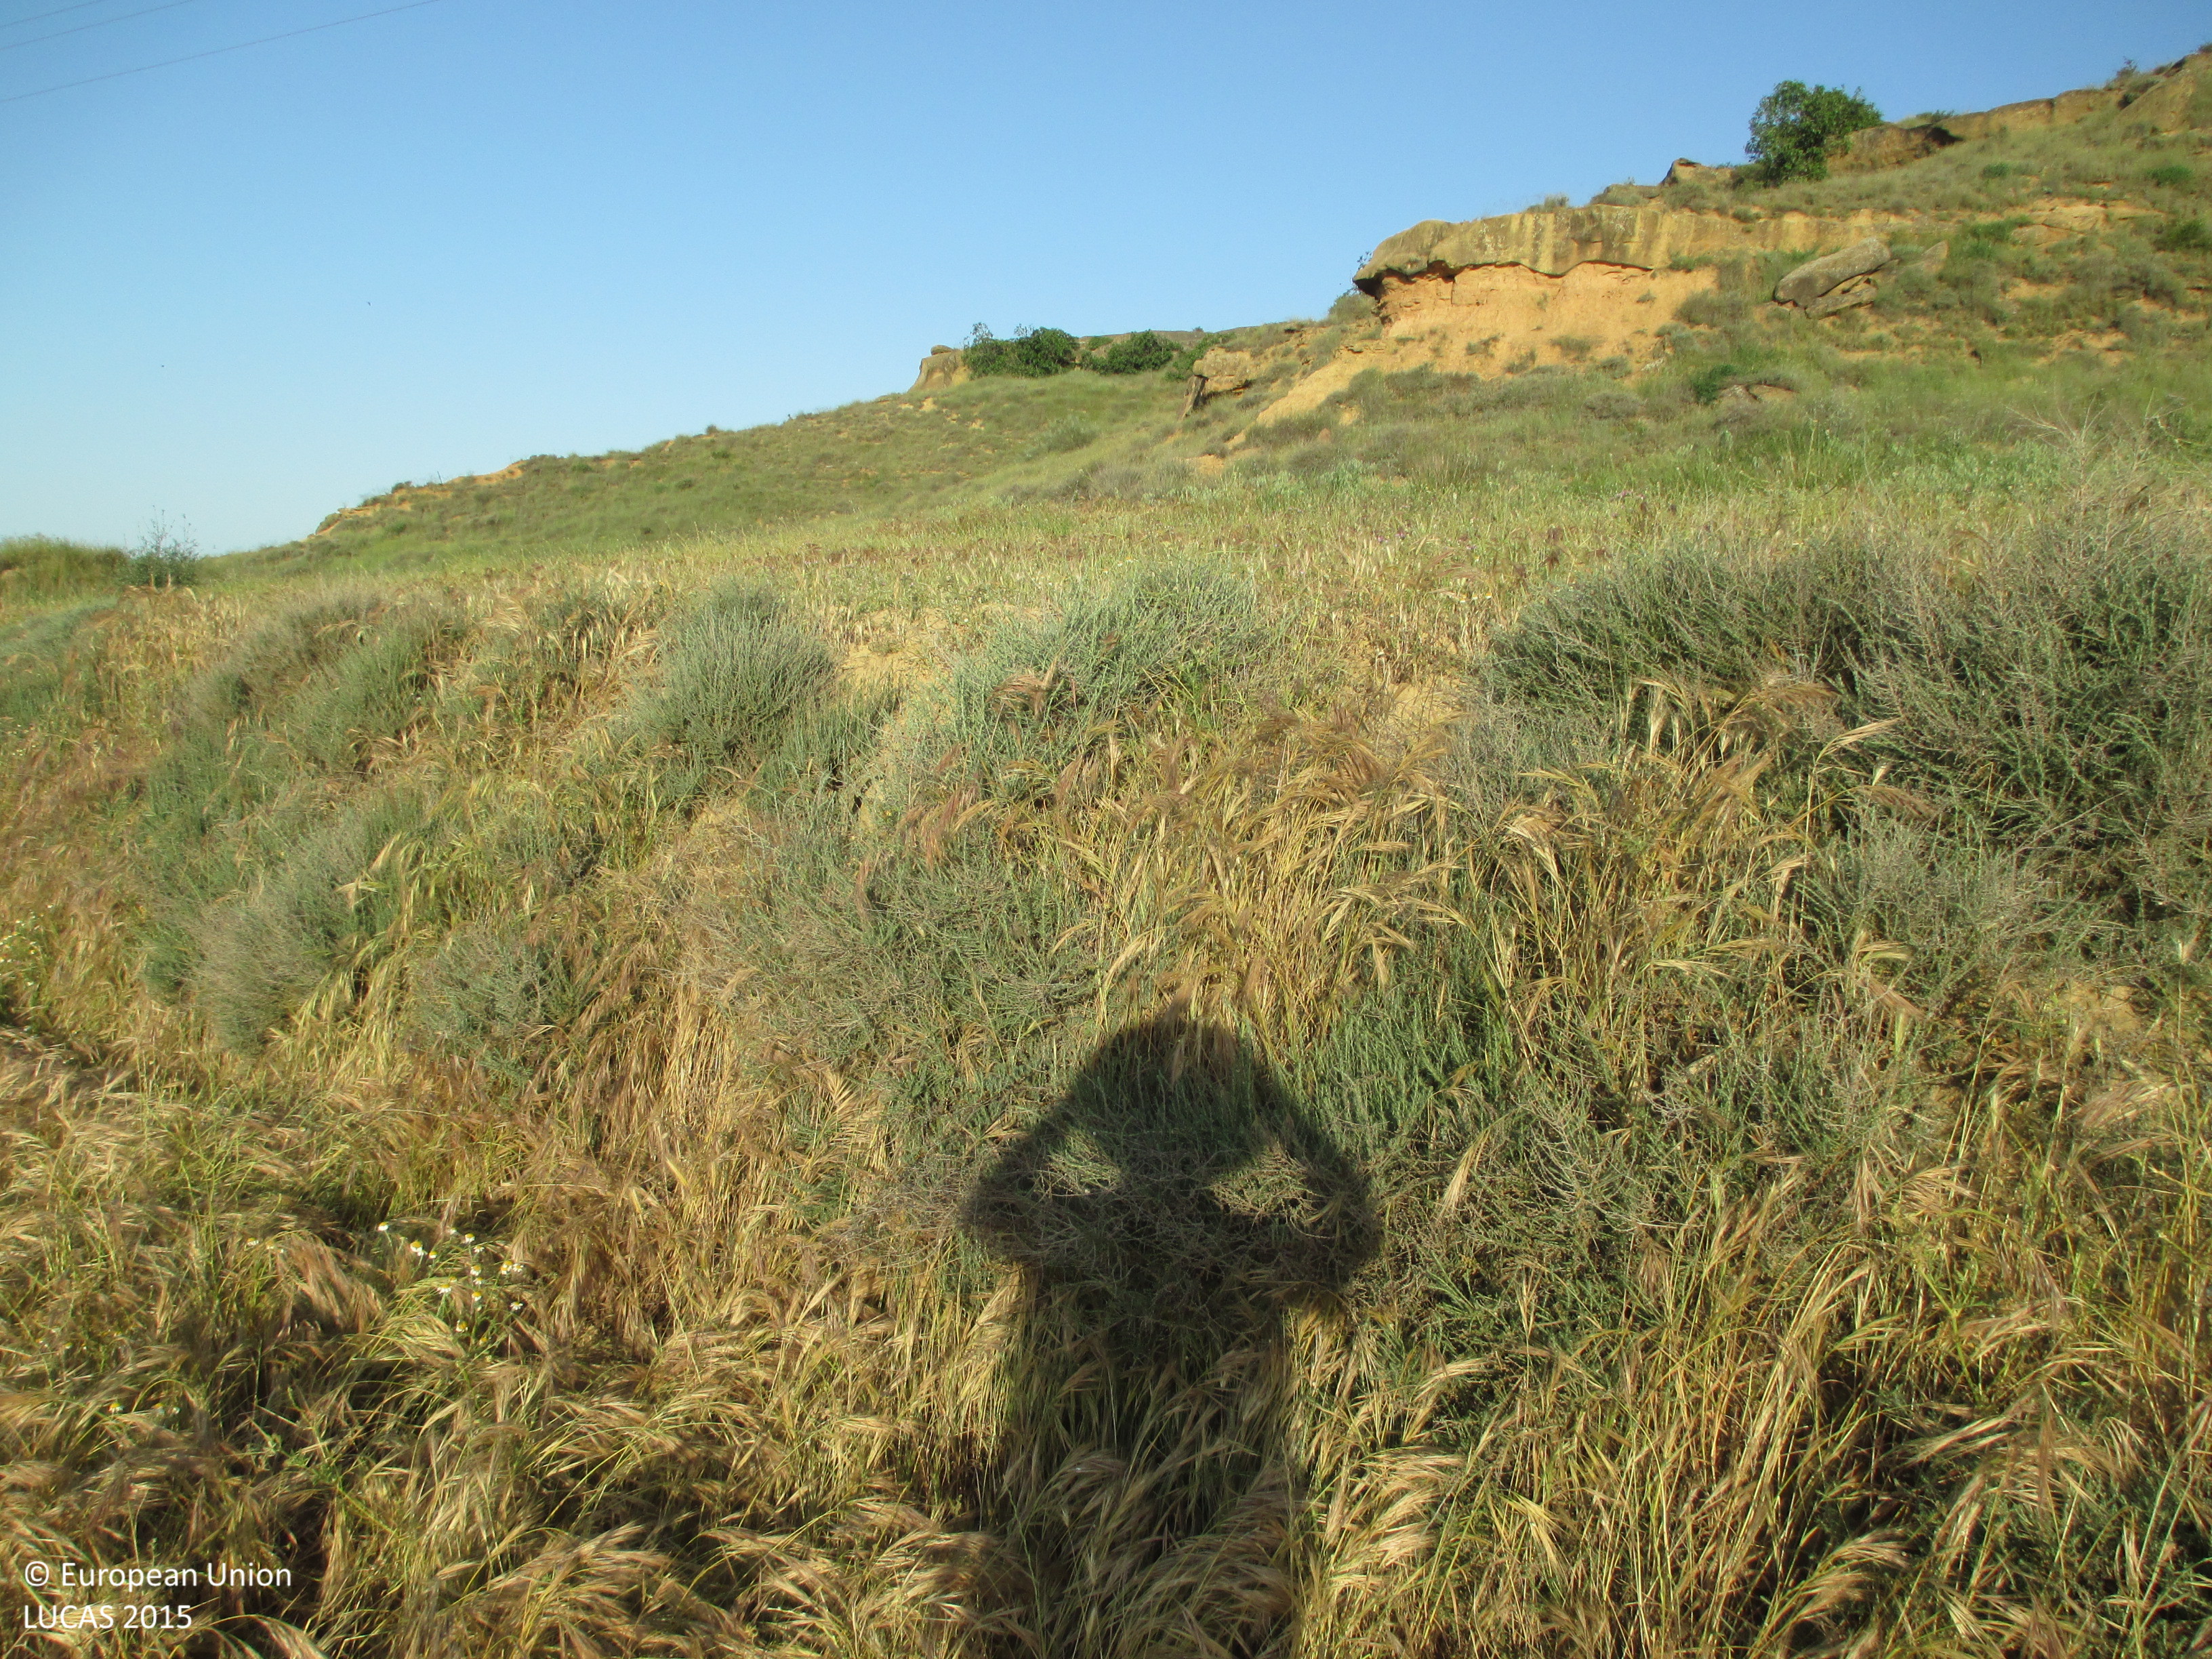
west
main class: Grassland
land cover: Spontaneously vegetated surfaces
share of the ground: > 75 %
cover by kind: herbaceous plants 100 %
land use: Fallow land
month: May
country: ES
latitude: 41.9933
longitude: -0.3664
